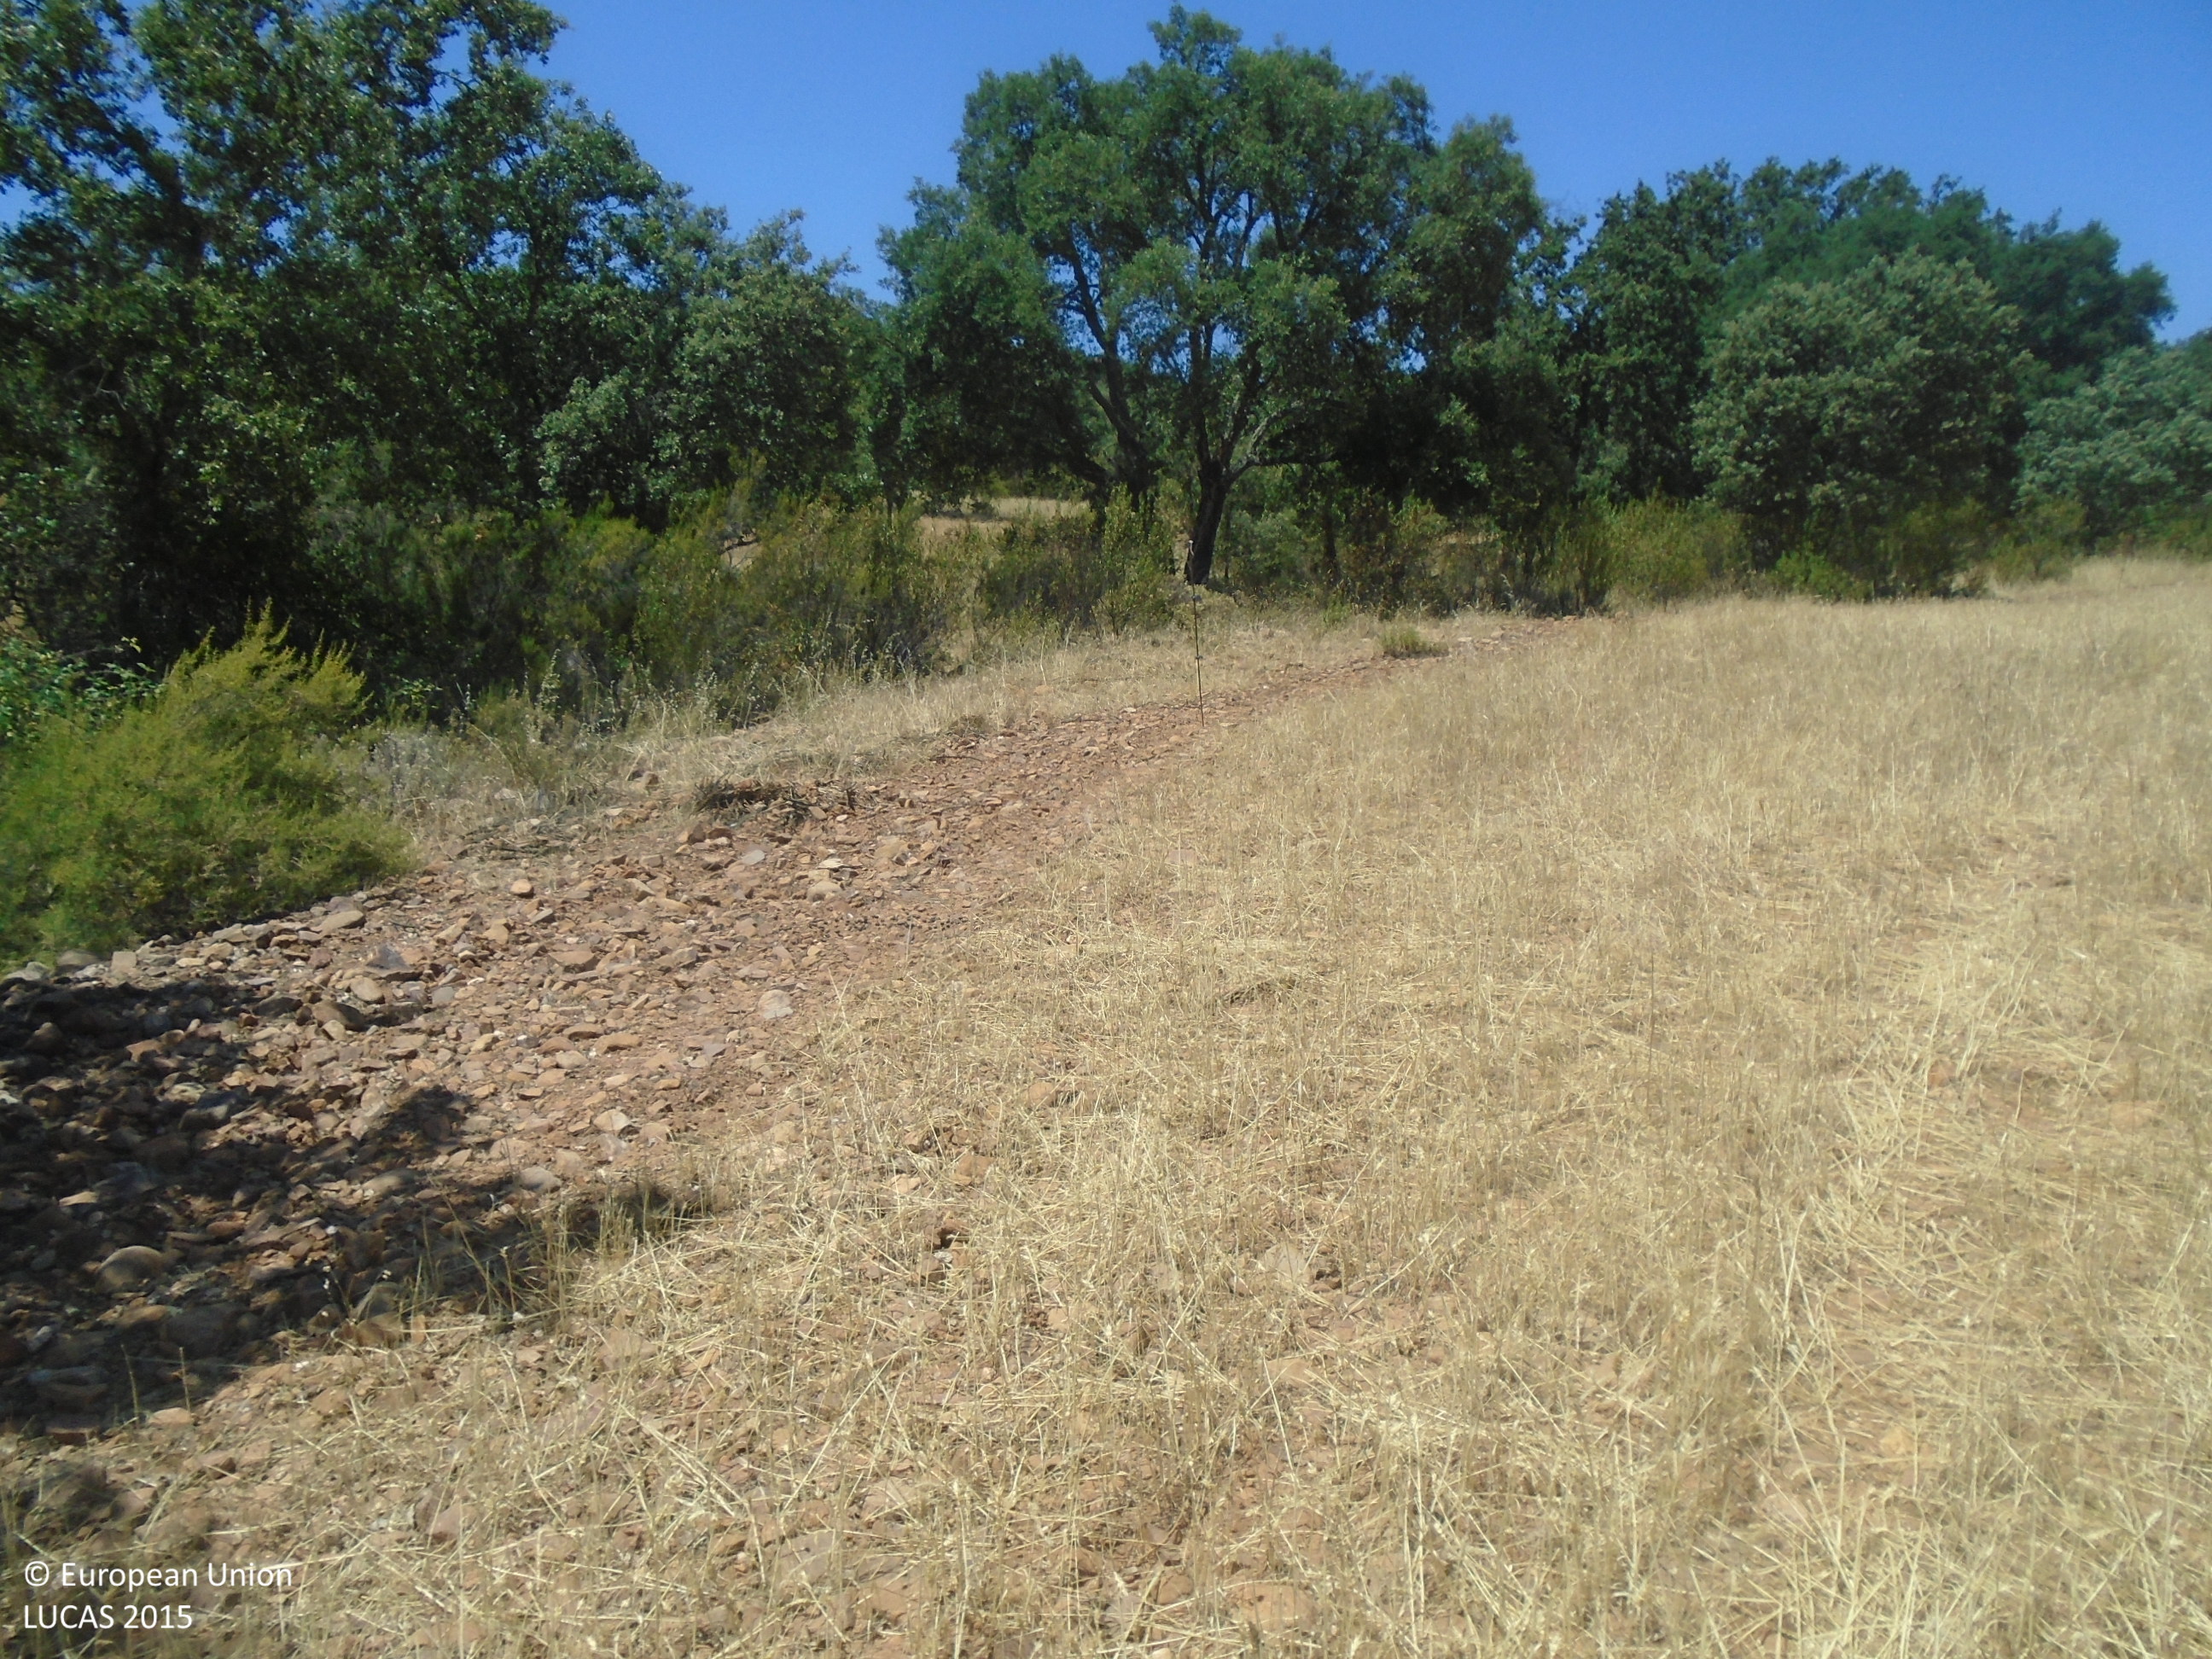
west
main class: Cropland
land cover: Mixed cereals for fodder
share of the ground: > 75 %
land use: Agriculture (excluding fallow land and kitchen gardens)
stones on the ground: > 50 %
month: July
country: ES
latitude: 39.4593
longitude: -4.8590
